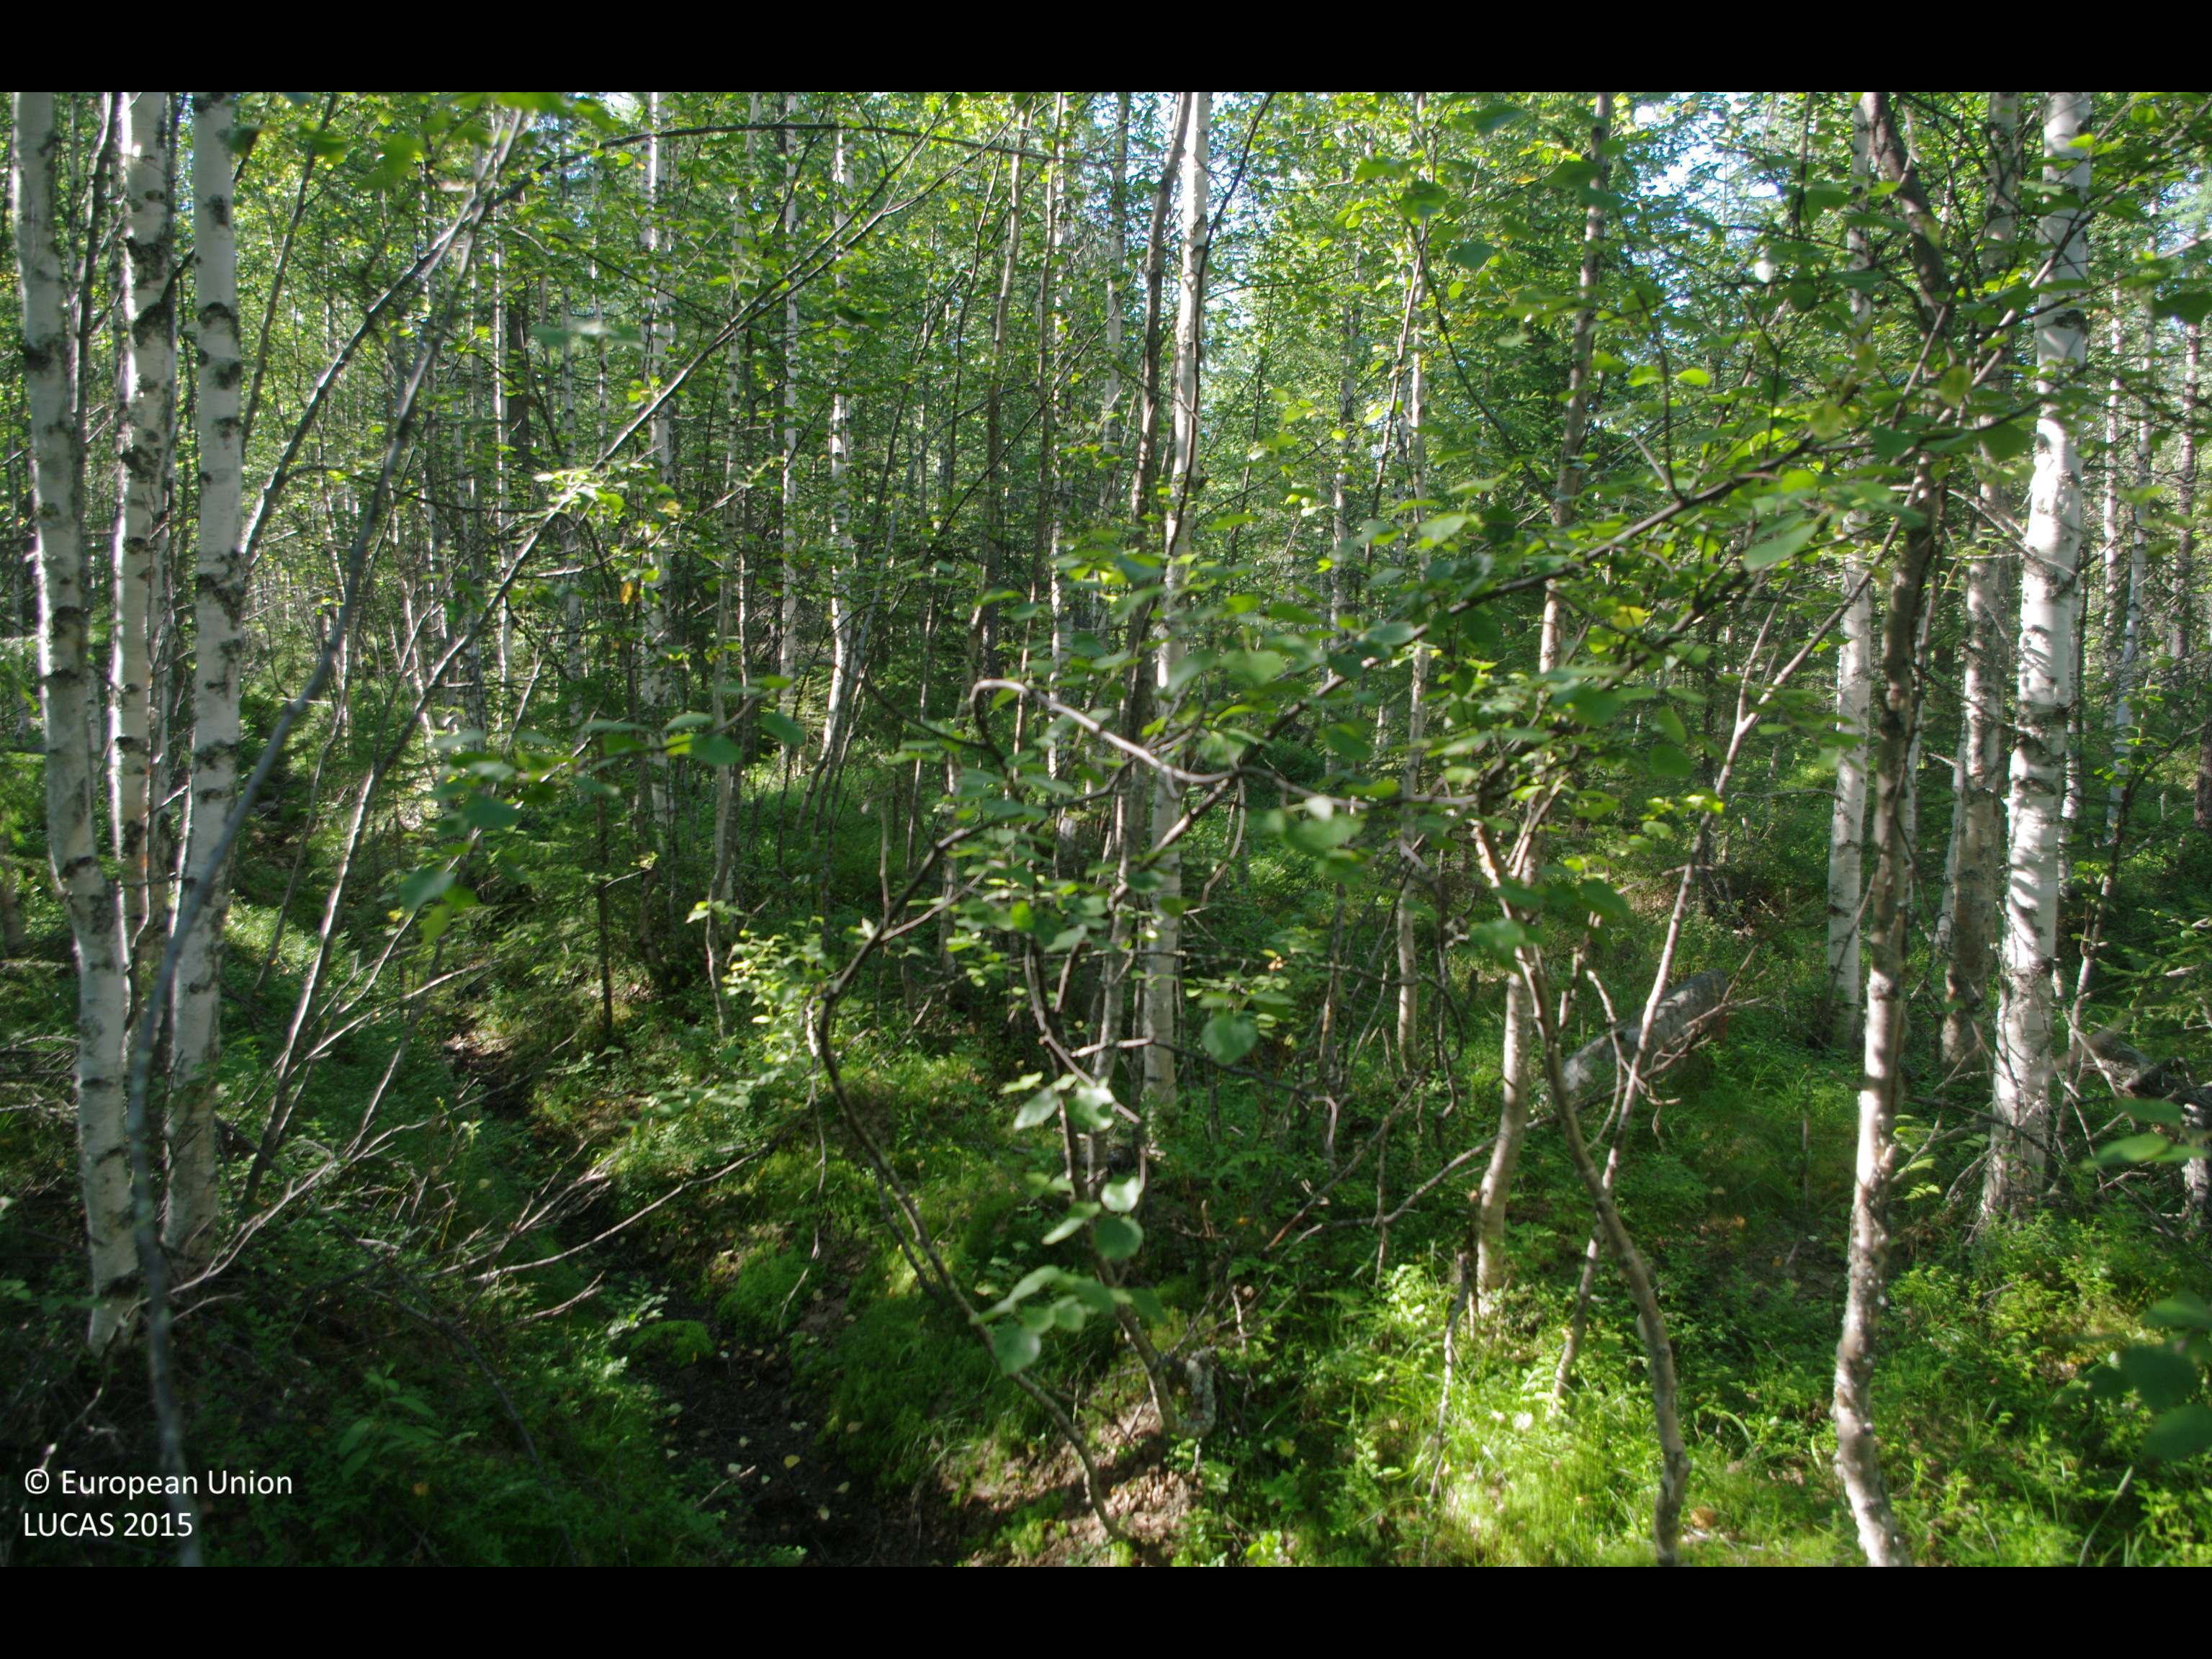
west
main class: Woodland
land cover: Other mixed woodland
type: boreal forest
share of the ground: > 75 %
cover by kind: broadleaved forest trees 50 %, coniferous forest trees 30 %, herbaceous plants 10 %, shrubs 5 %, lichens and mosses 5 %
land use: Forestry
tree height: > 5 m
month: August
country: FI
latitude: 65.6544
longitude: 28.1254
